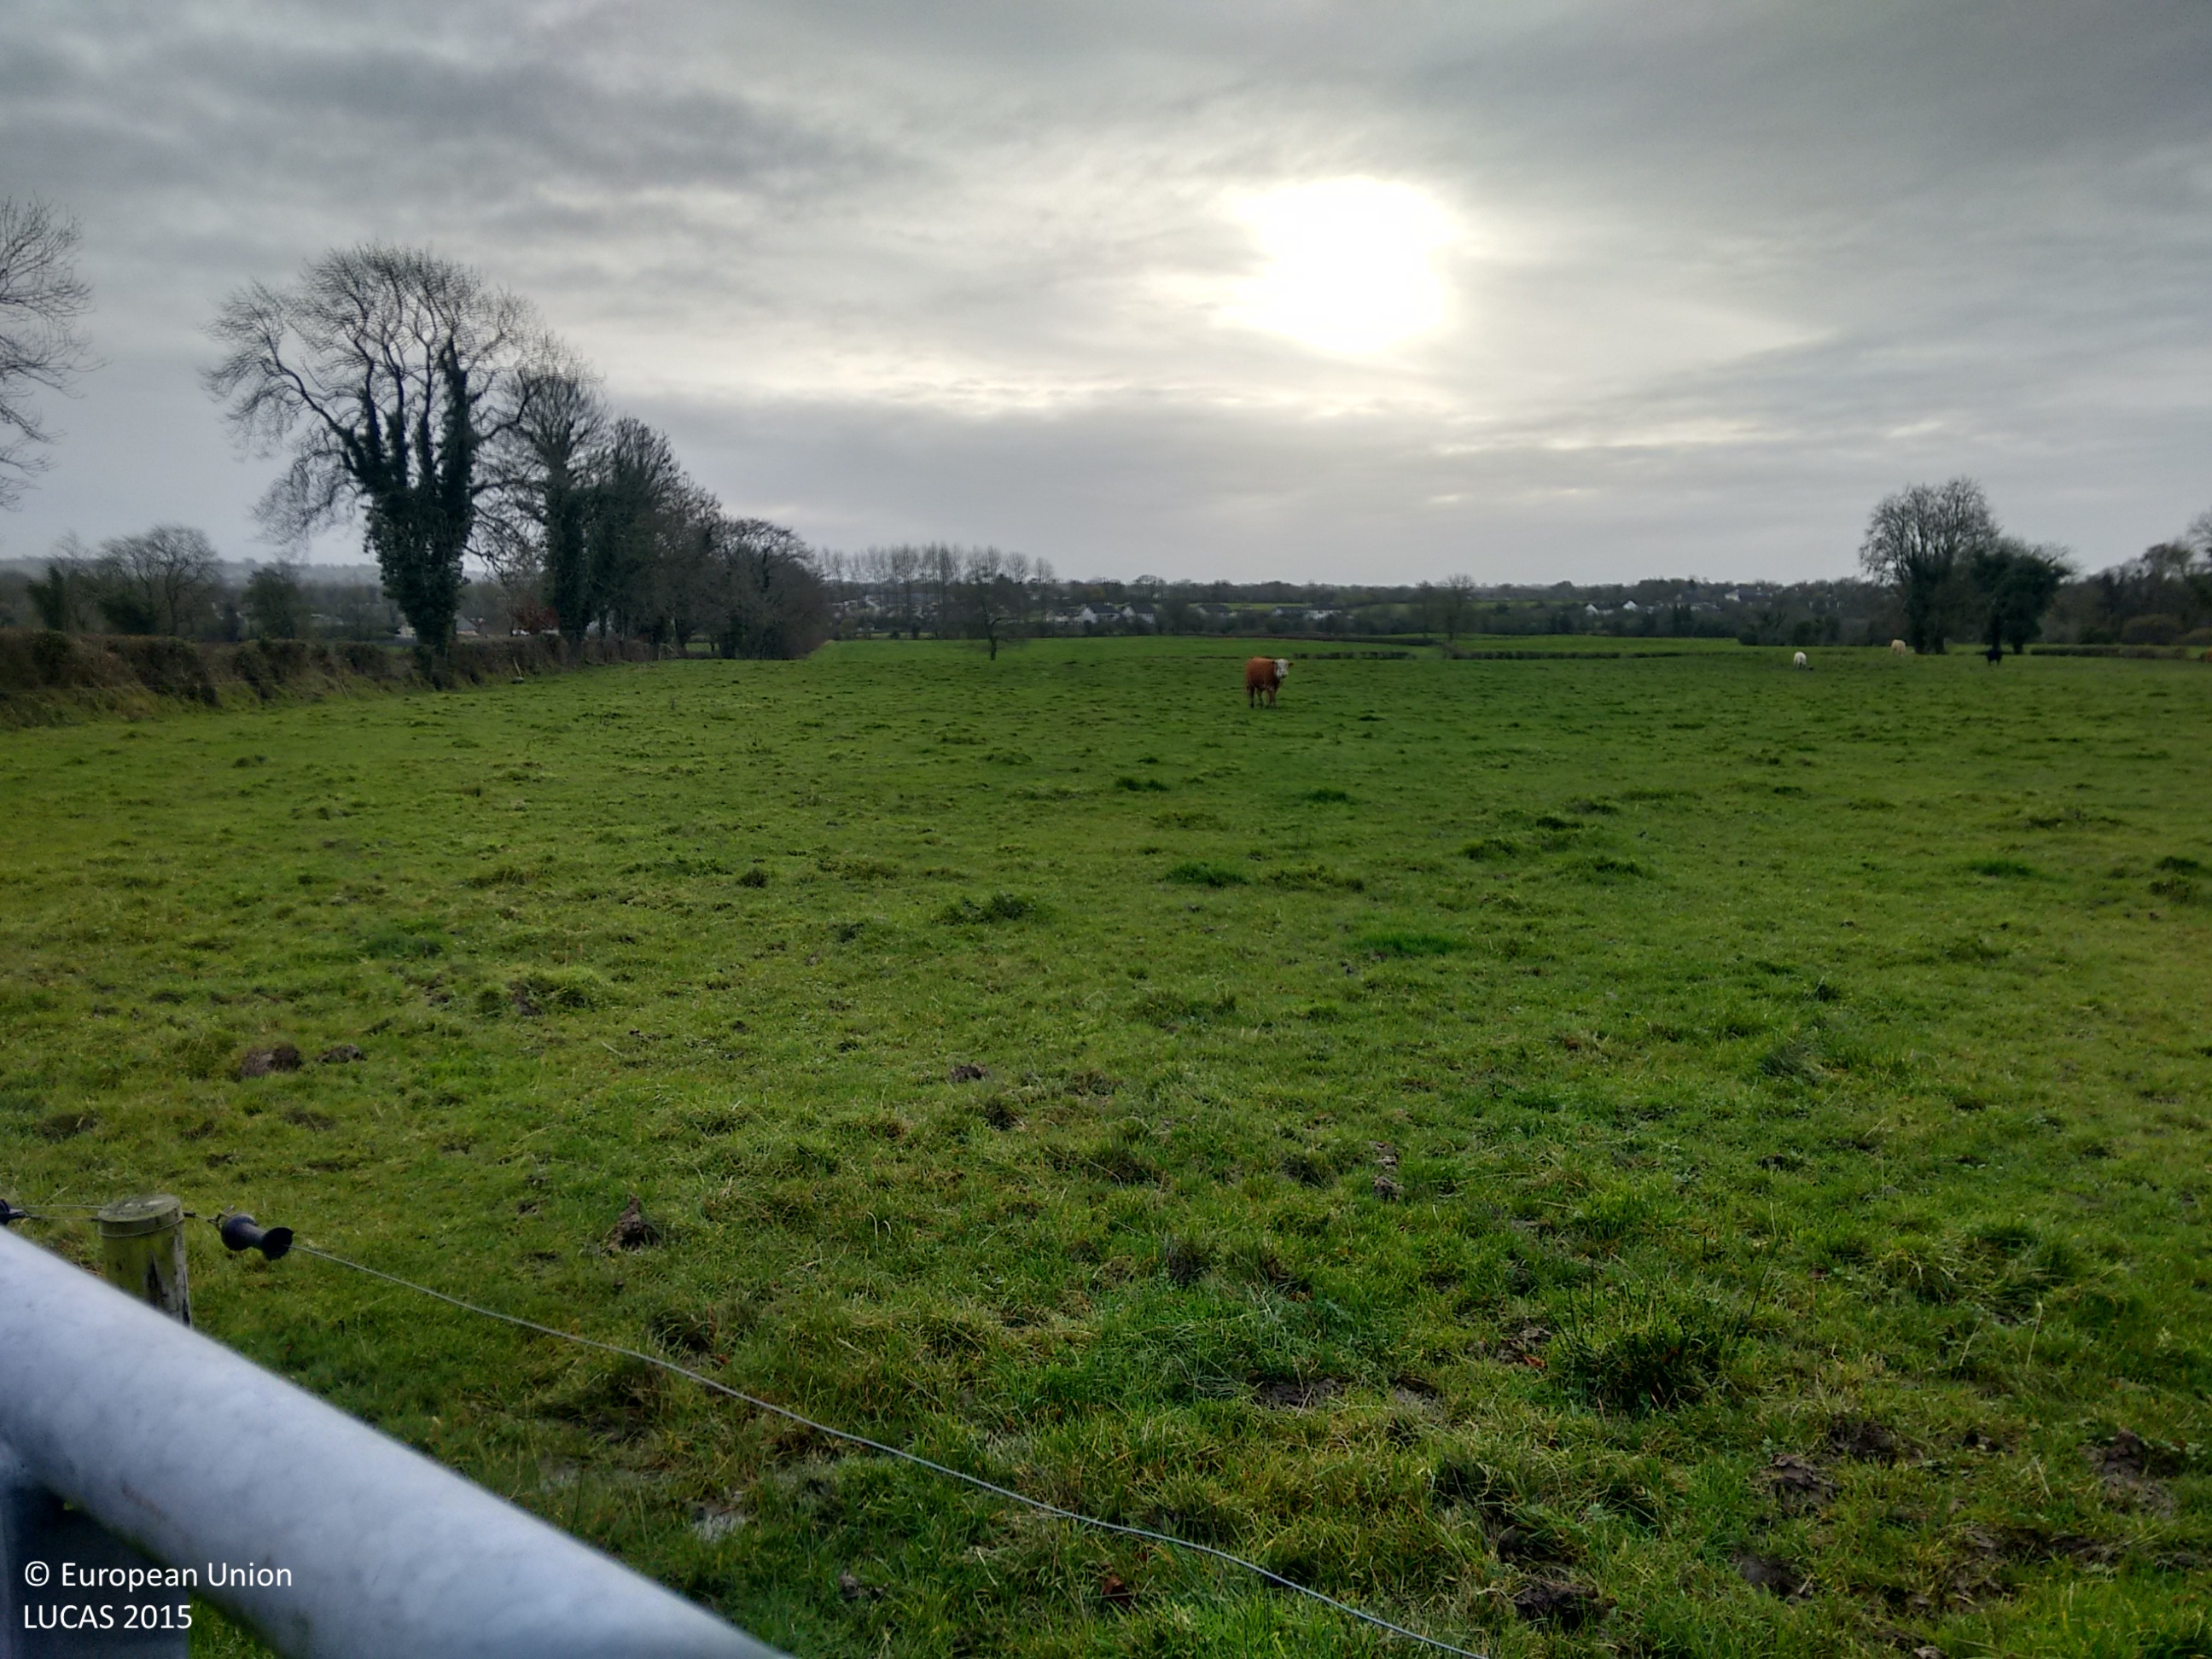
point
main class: Grassland
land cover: Grassland without tree/shrub cover
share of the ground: > 75 %
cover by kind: herbaceous plants 100 %
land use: Agriculture (excluding fallow land and kitchen gardens)
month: November
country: IE
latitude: 53.7671
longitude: -7.7806
